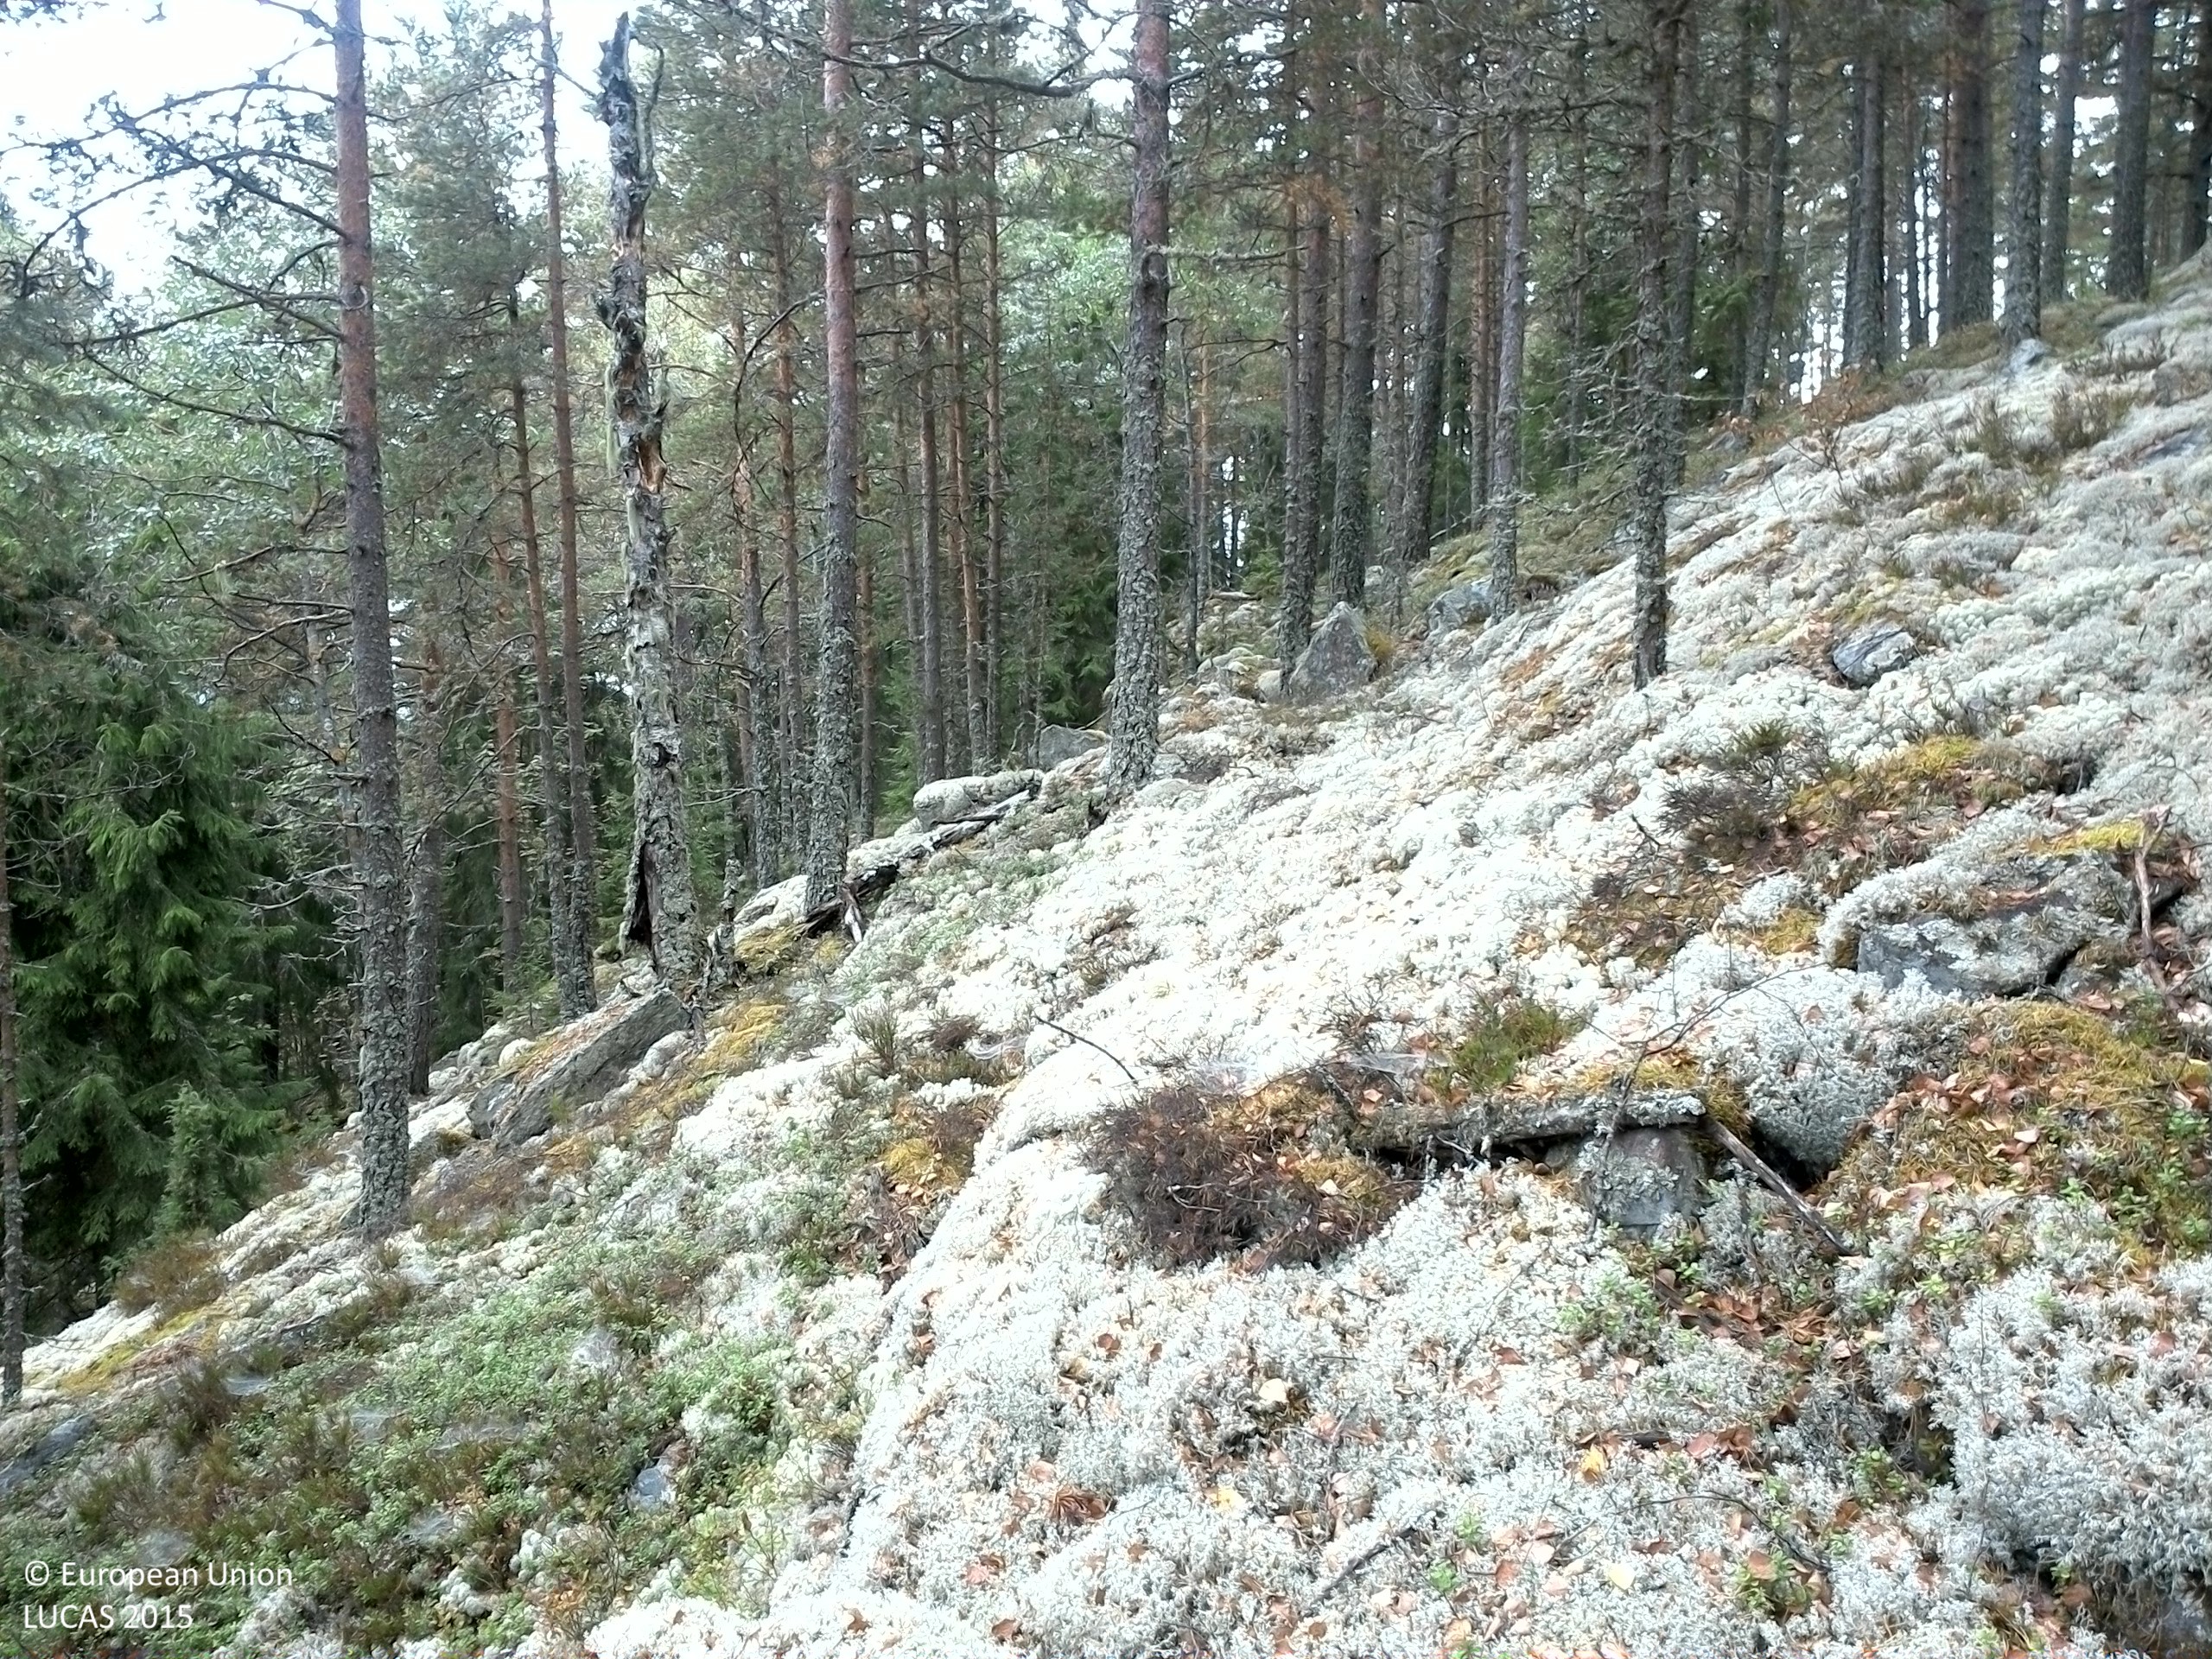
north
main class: Woodland
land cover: Pine dominated coniferous woodland
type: boreal forest
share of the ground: 50 - 75 %
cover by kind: coniferous forest trees 70 %, lichens and mosses 20 %, broadleaved forest trees 5 %, shrubs 5 %
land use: Forestry
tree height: > 5 m
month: September
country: SE
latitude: 59.7820
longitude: 13.2871
